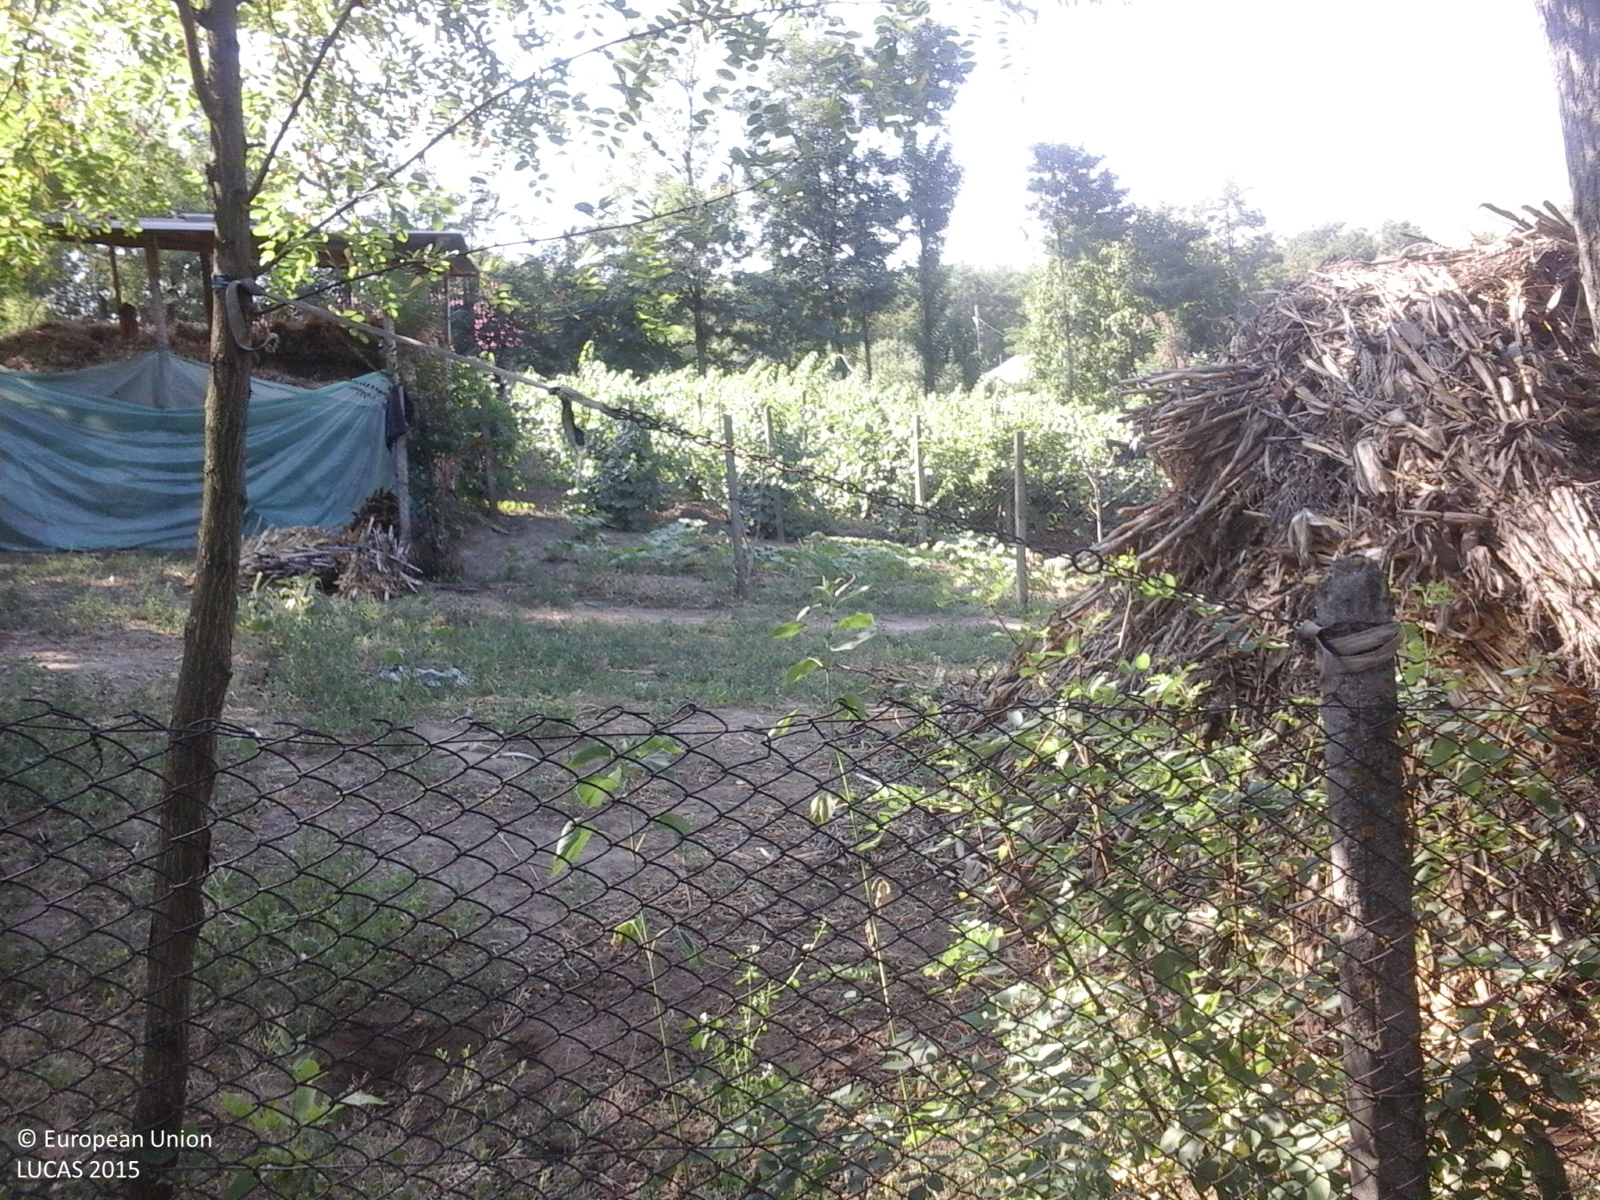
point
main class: Cropland
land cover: Vineyards
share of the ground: > 75 %
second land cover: Other bare soil
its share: > 75 %
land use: Kitchen garden
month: July
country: RO
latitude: 46.1601
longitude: 27.5263
